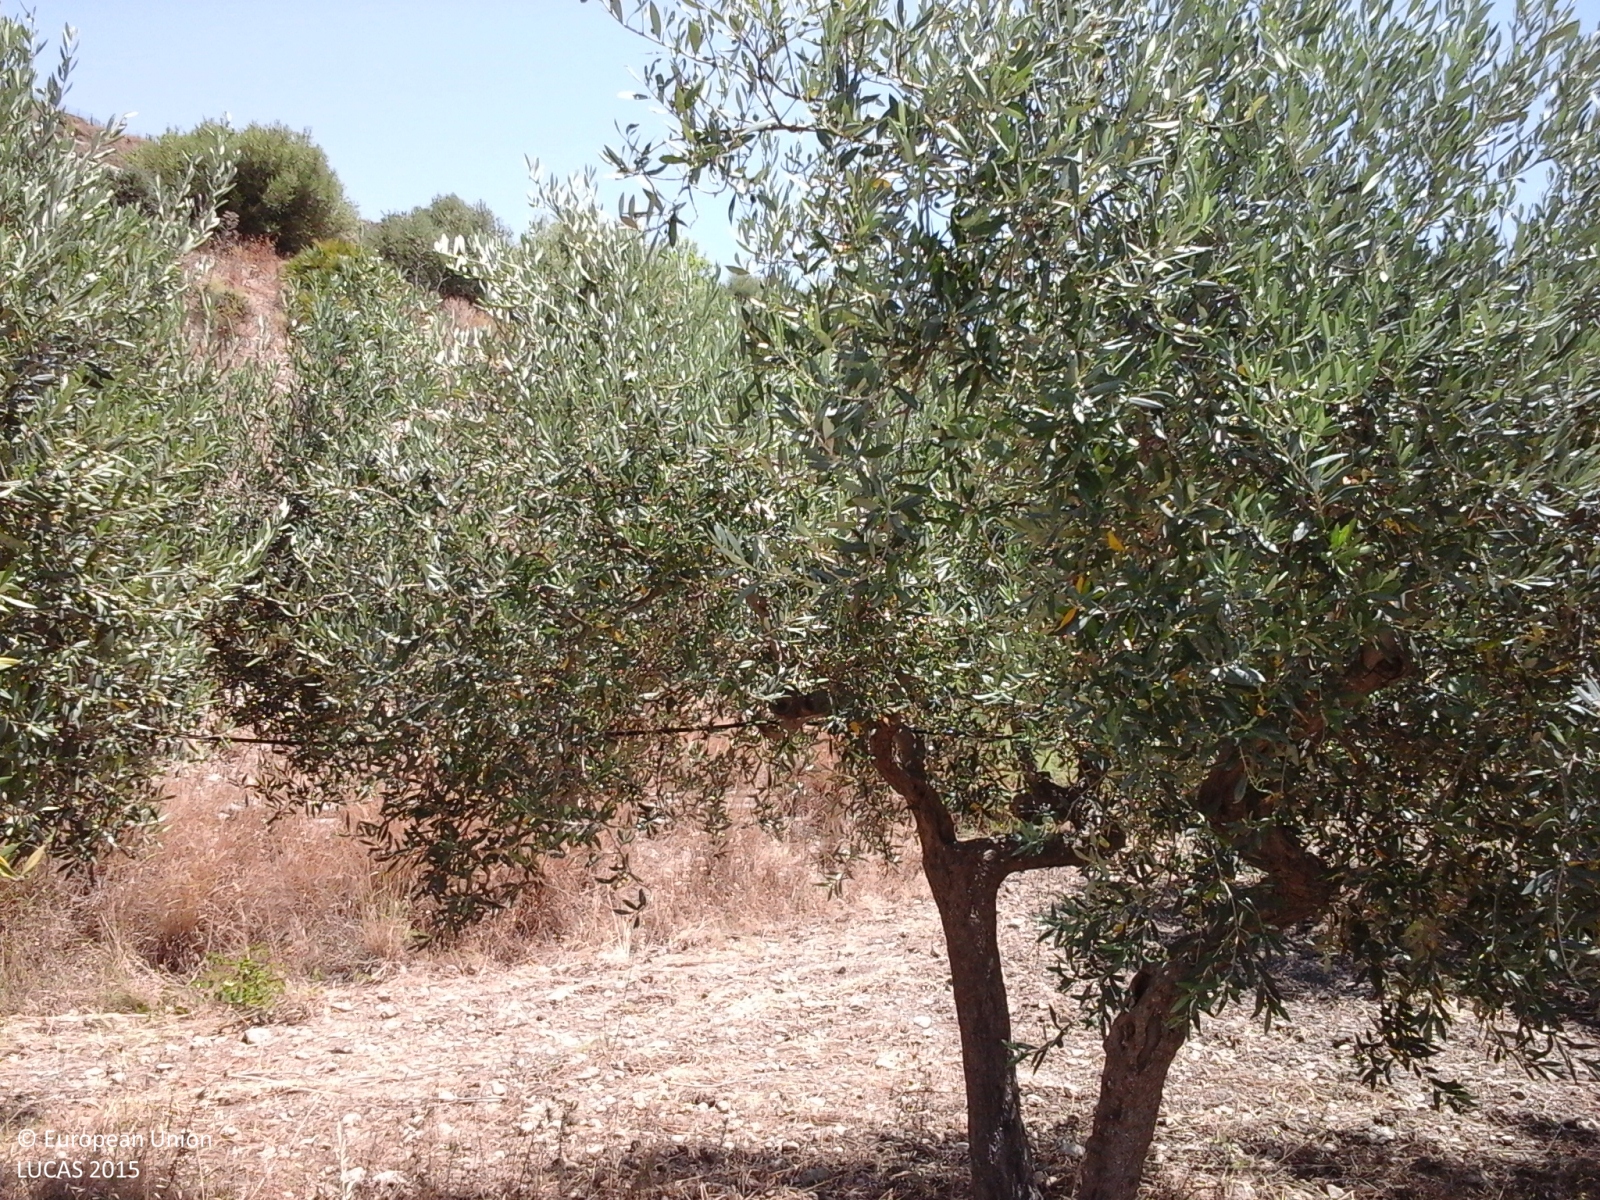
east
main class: Cropland
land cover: Olive groves
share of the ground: 50 - 75 %
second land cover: Other bare soil
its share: > 75 %
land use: Agriculture (excluding fallow land and kitchen gardens)
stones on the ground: 10 - 25 %
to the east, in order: Olive groves; Other bare soil; Grassland with sparse tree/shrub cover; Artificial constructions; Grassland with sparse tree/shrub cover; Grass margins; Tracks; Grass margins; Grassland with sparse tree/shrub cover
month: June
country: IT
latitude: 37.6079
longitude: 13.0467
